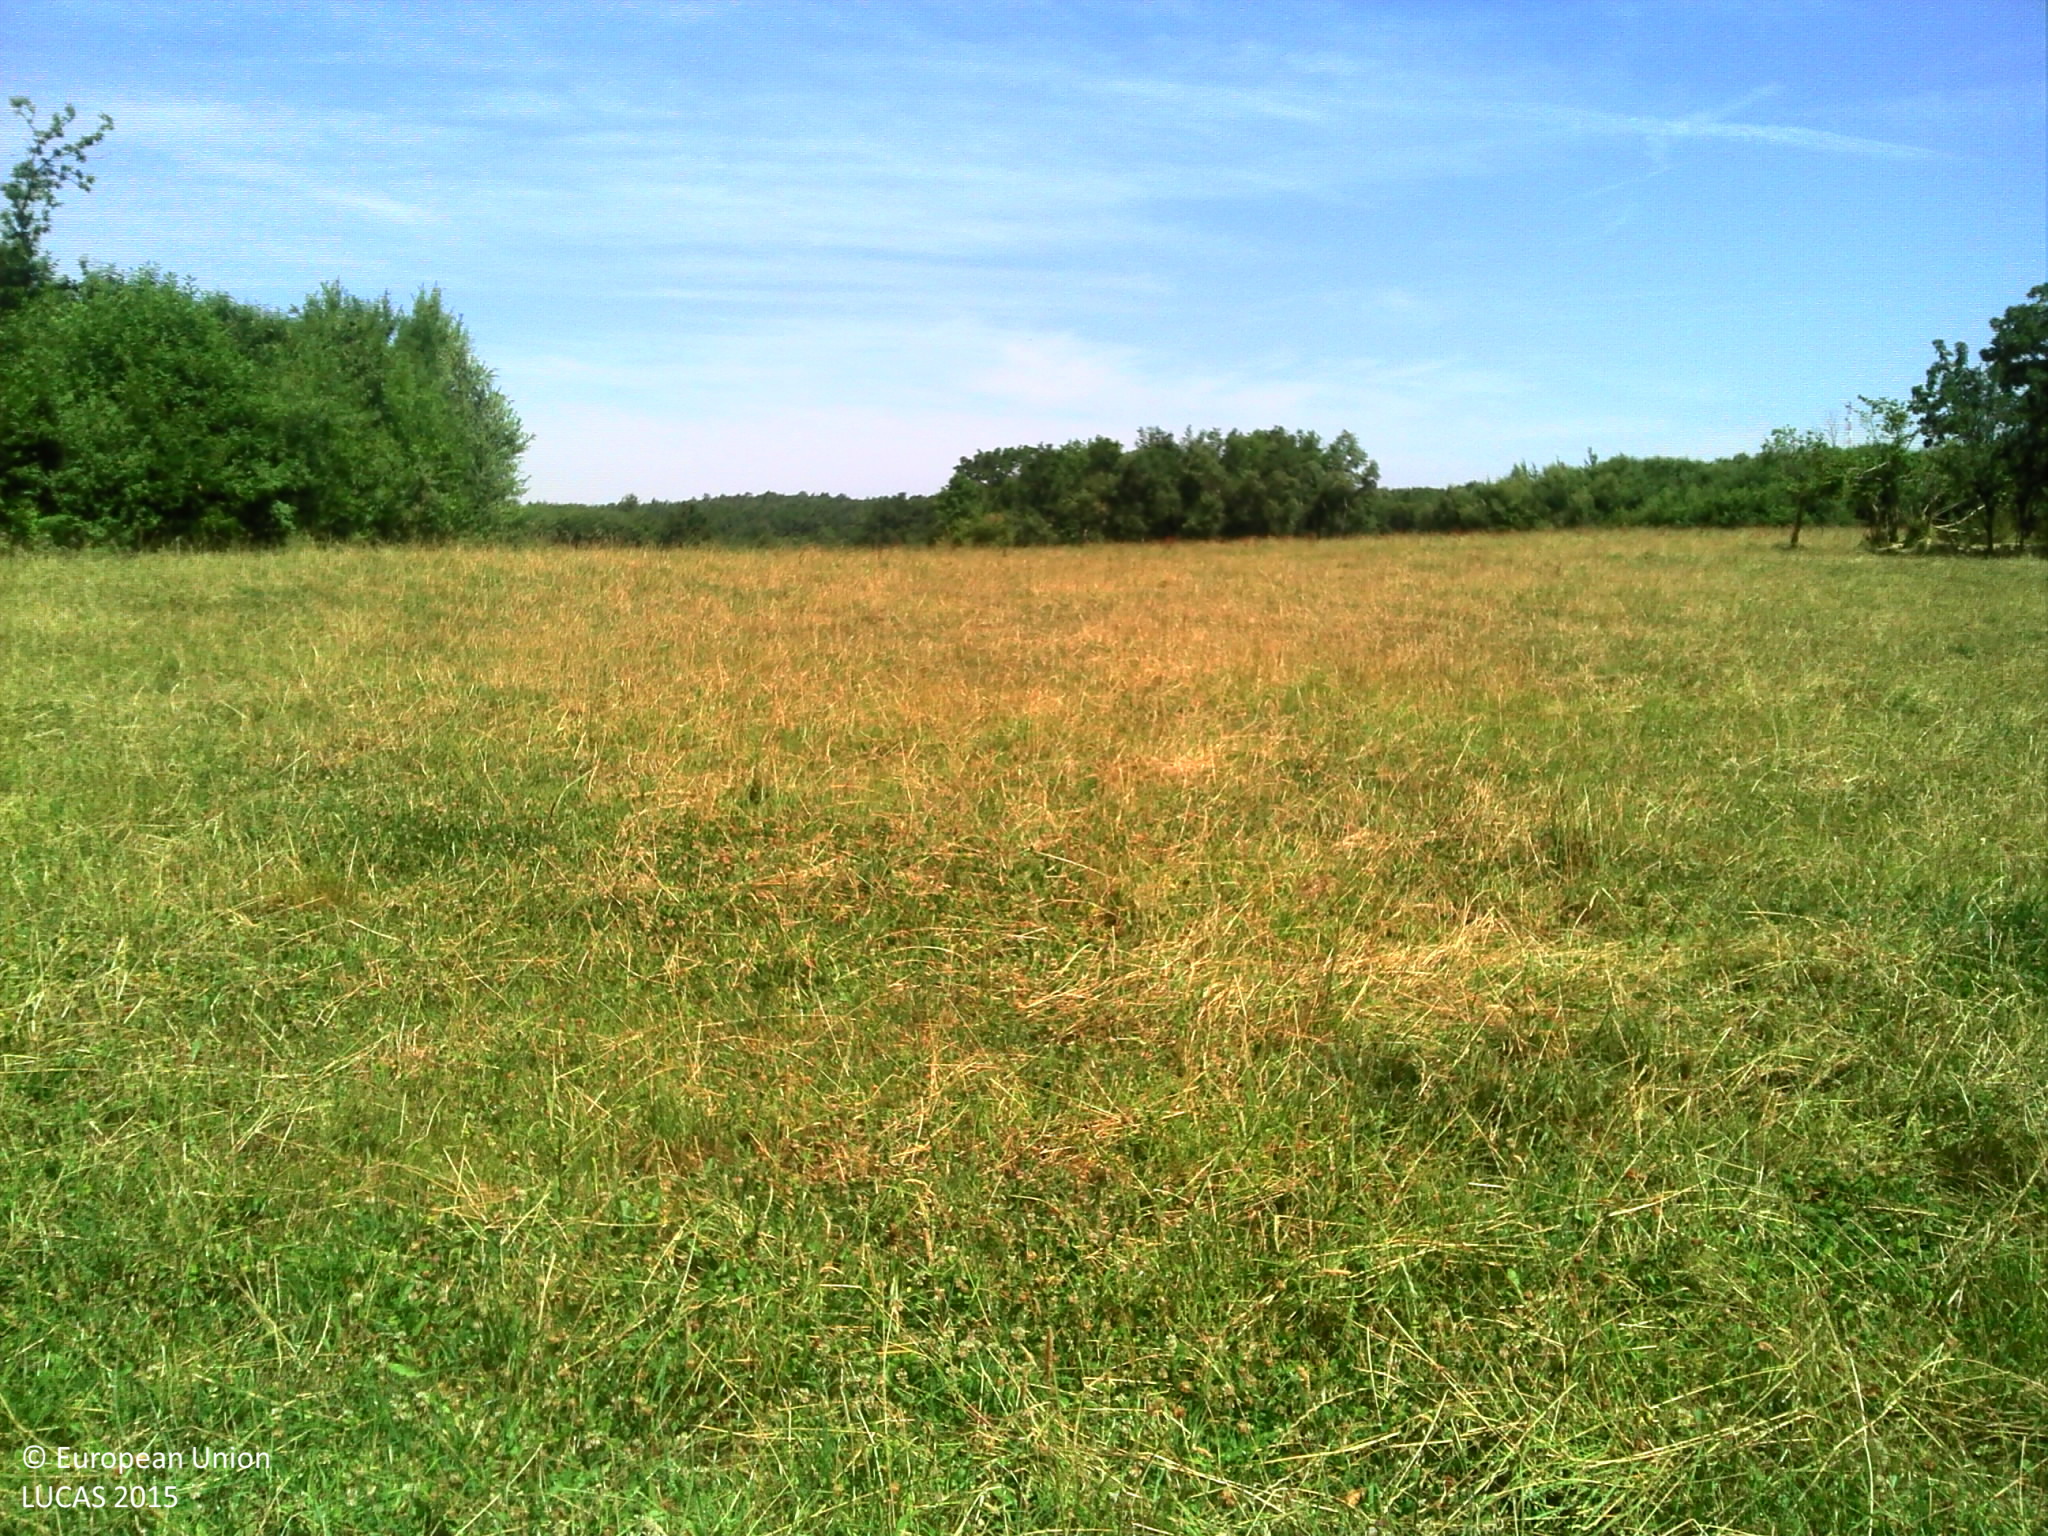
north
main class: Grassland
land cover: Grassland without tree/shrub cover
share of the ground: > 75 %
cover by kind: herbaceous plants 100 %
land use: Agriculture (excluding fallow land and kitchen gardens)
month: July
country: FR
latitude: 45.2689
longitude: 5.2000
